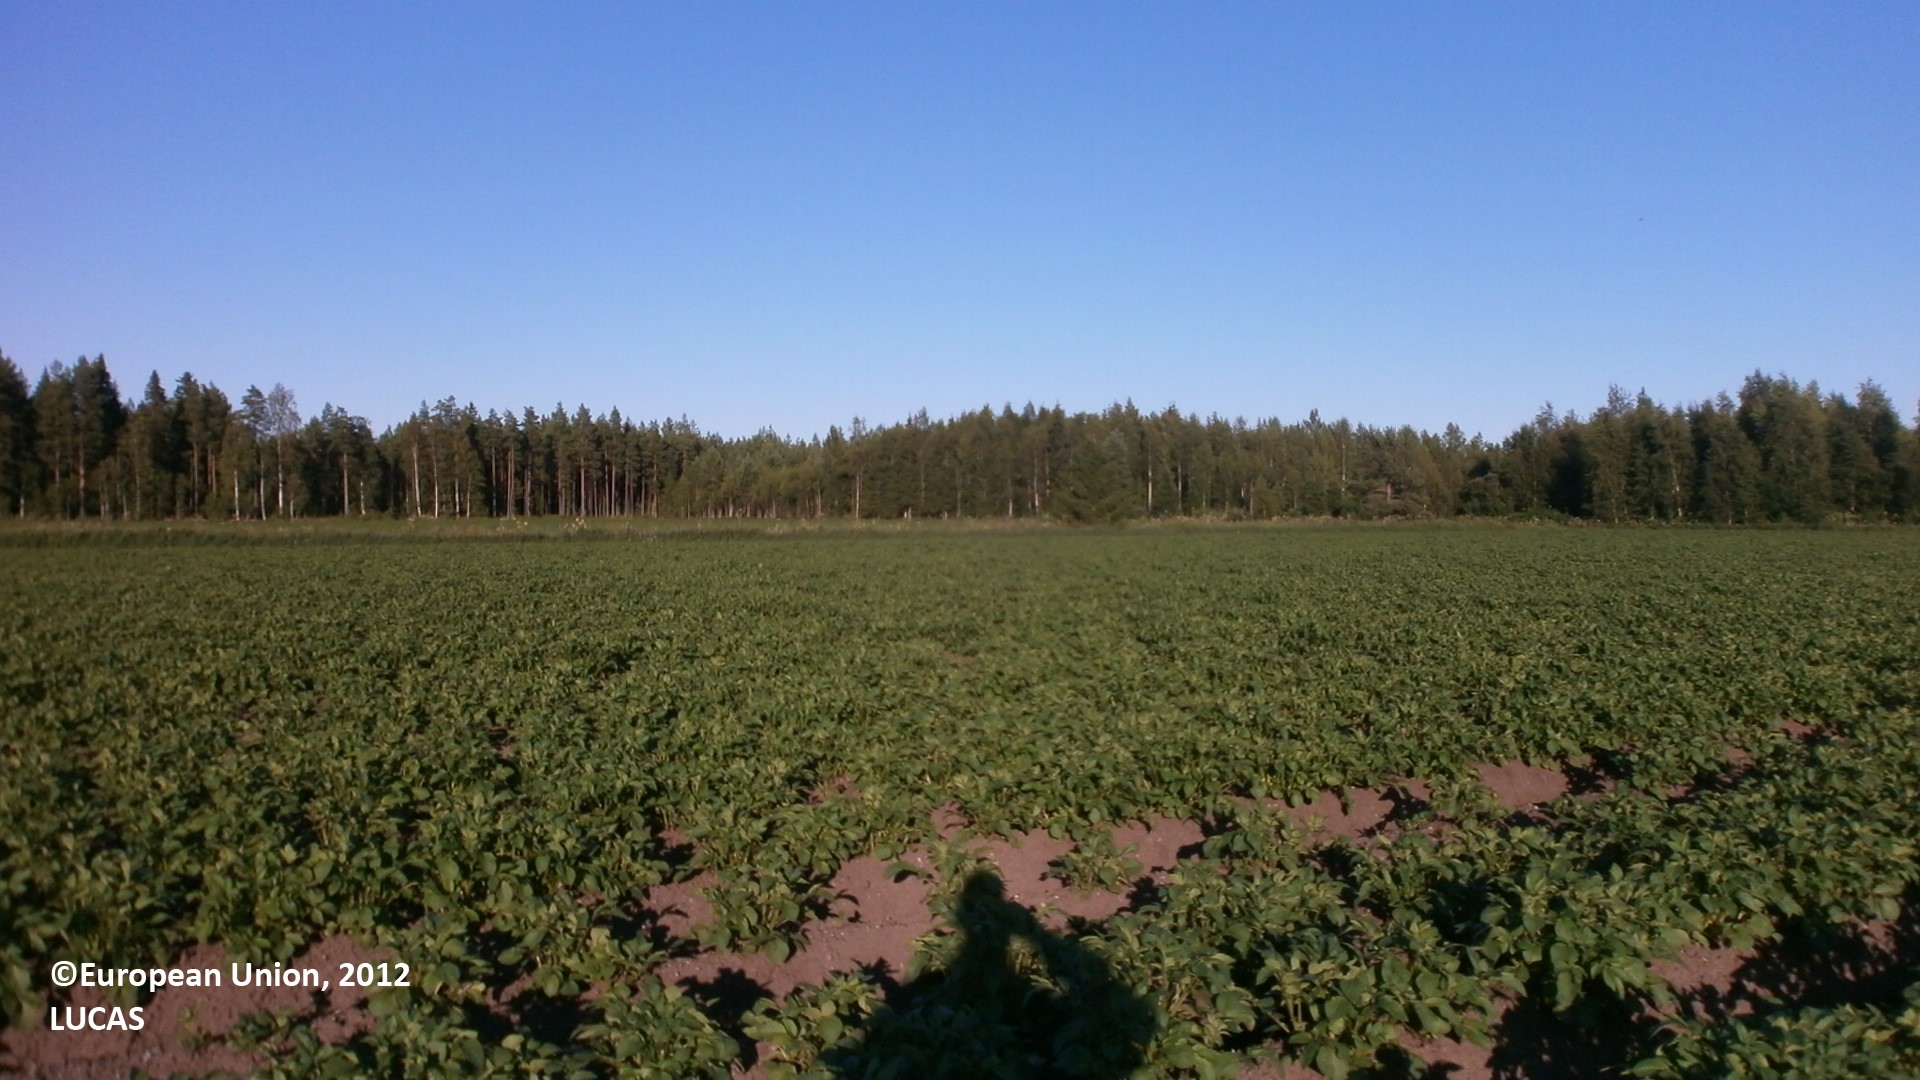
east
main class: Cropland
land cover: Potatoes
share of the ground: 25 - 50 %
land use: Agriculture (excluding fallow land and kitchen gardens)
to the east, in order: Potatoes; Other bare soil; Shruby margins; Ditches and canals; Shruby margins; Potatoes; Shruby margins; Ditches and canals; Pine dominated coniferous woodland
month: July
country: FI
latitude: 64.1857
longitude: 24.1235
